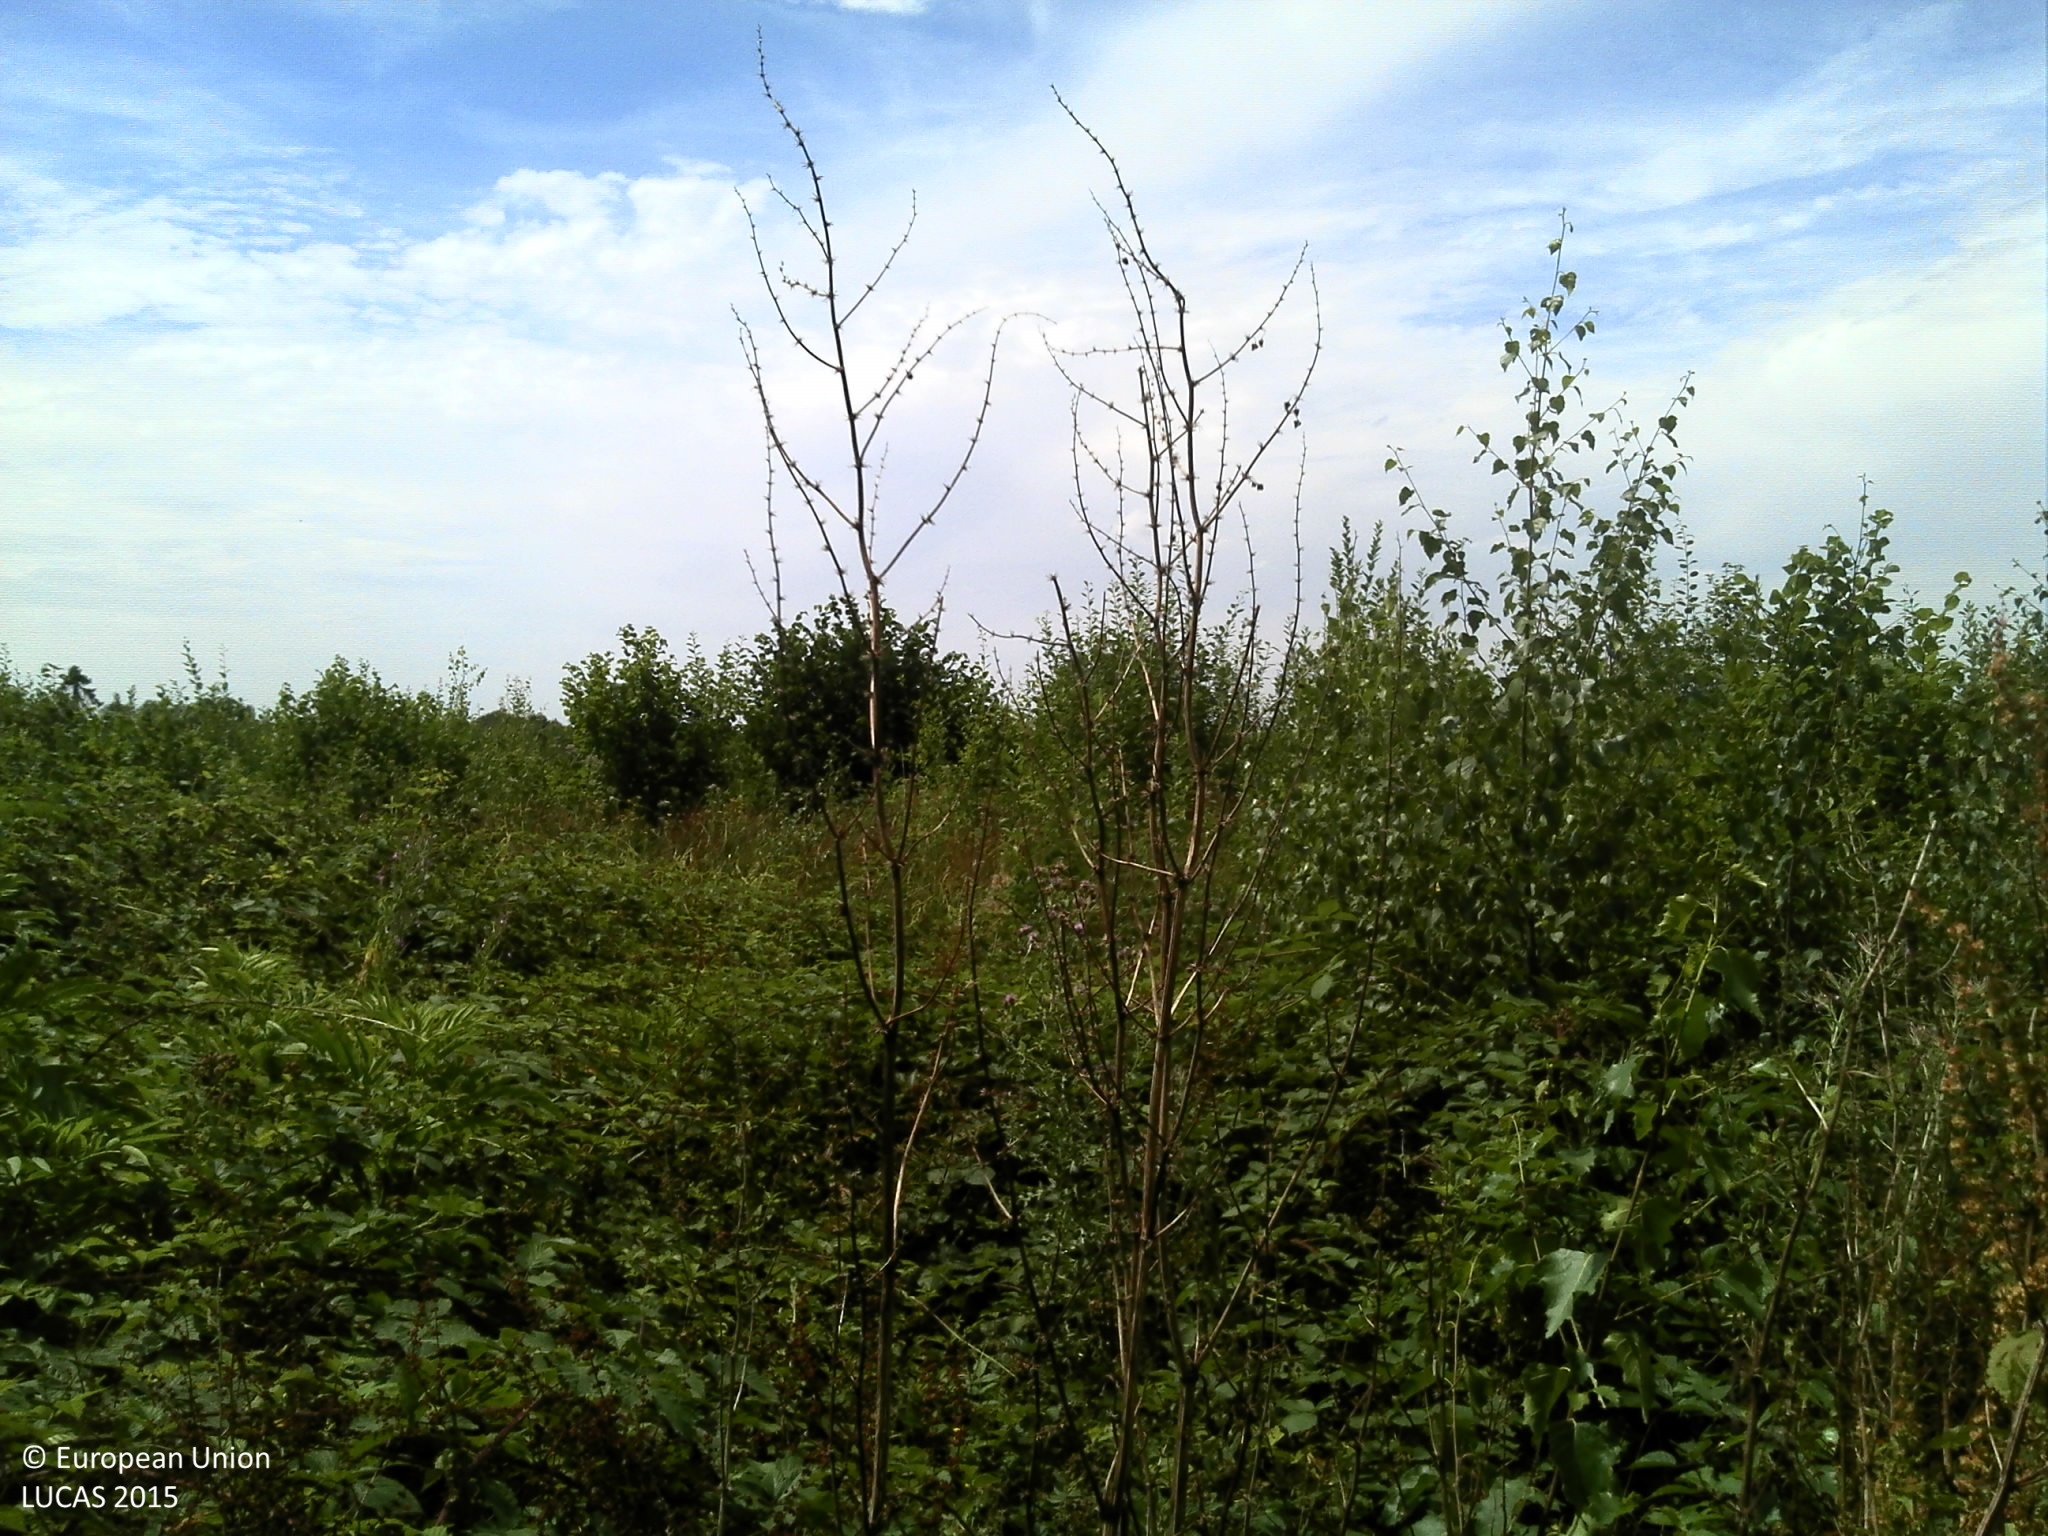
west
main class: Woodland
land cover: Broadleaved woodland
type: non-riverine alder, birch or aspen forest
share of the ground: > 75 %
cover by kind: broadleaved forest trees 50 %, herbaceous plants 50 %
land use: Forestry
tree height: < 5 m
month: July
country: FR
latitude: 49.6245
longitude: 4.2505
